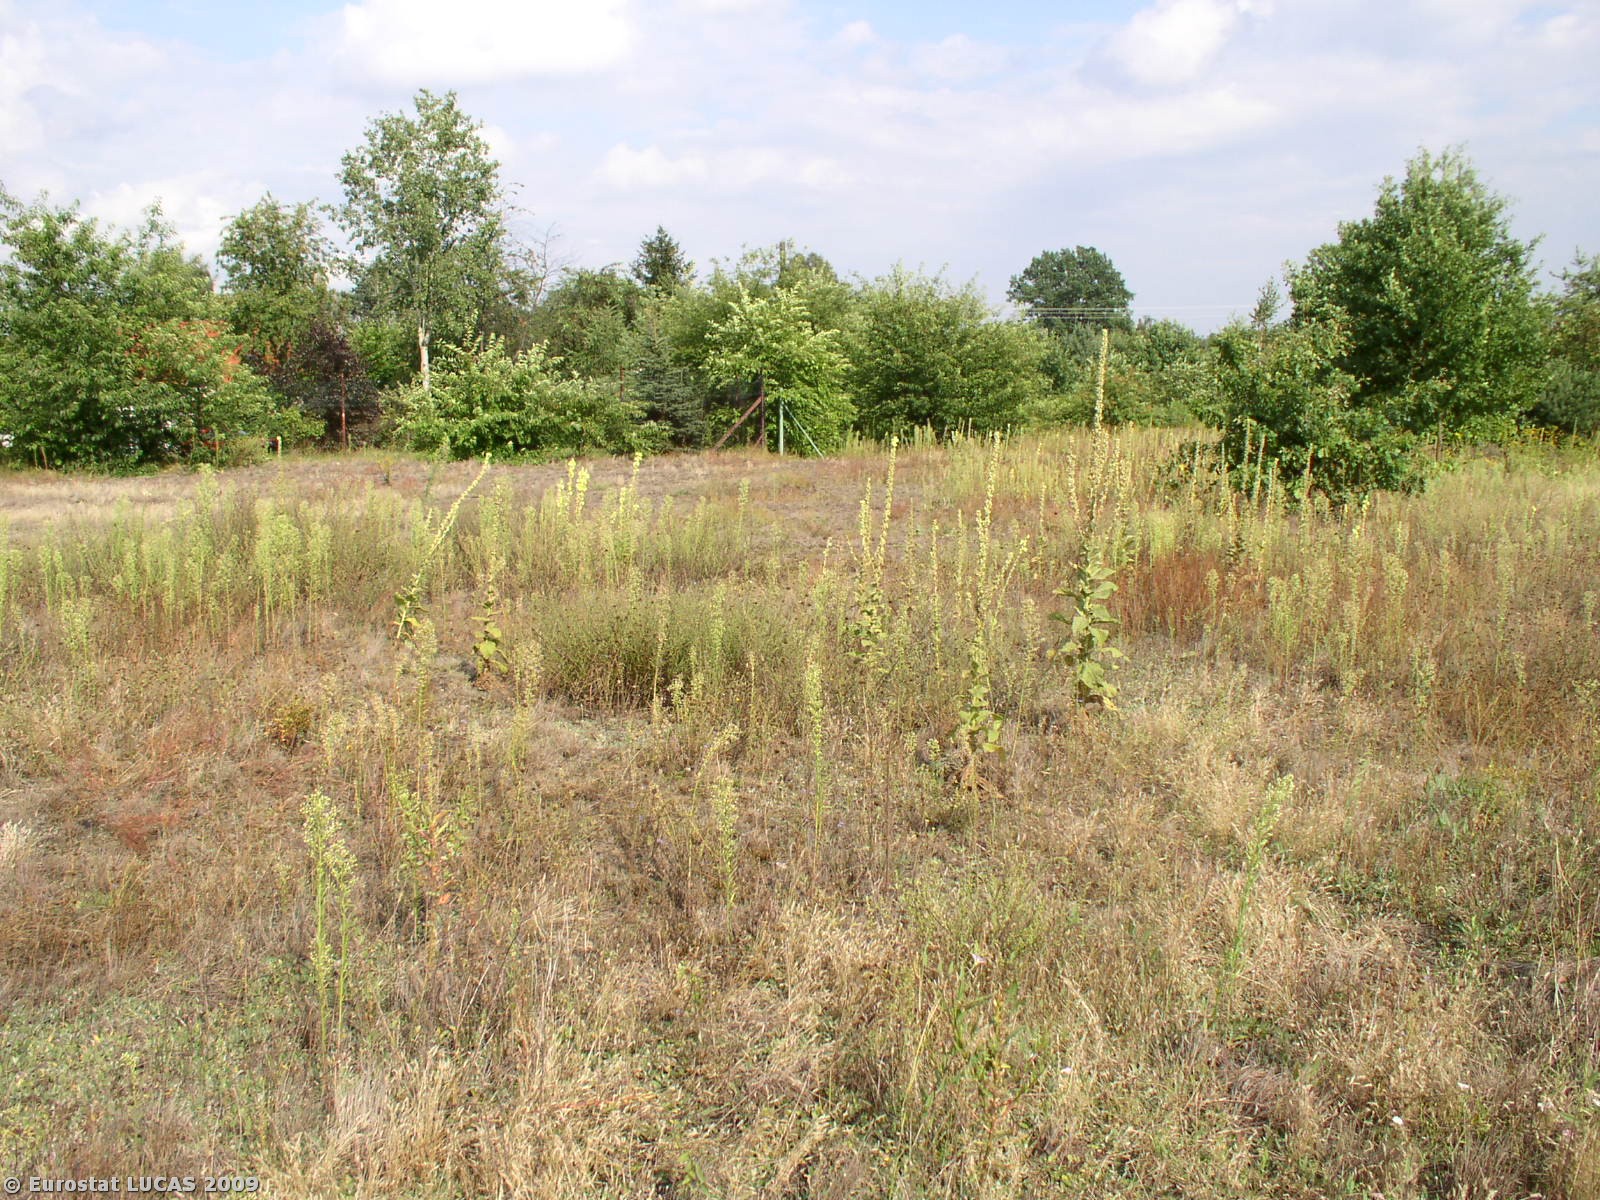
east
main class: Grassland
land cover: Spontaneously vegetated surfaces
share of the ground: > 75 %
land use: Unused
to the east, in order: Spontaneously vegetated surfaces; Grassland with sparse tree/shrub cover; Electric lines; Tracks; Grass margins; Fences; Artificial constructions in urban areas; Grassland with sparse tree/shrub cover; Fences; Broadleaved woodland
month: August
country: PL
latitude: 52.2402
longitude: 21.2506
